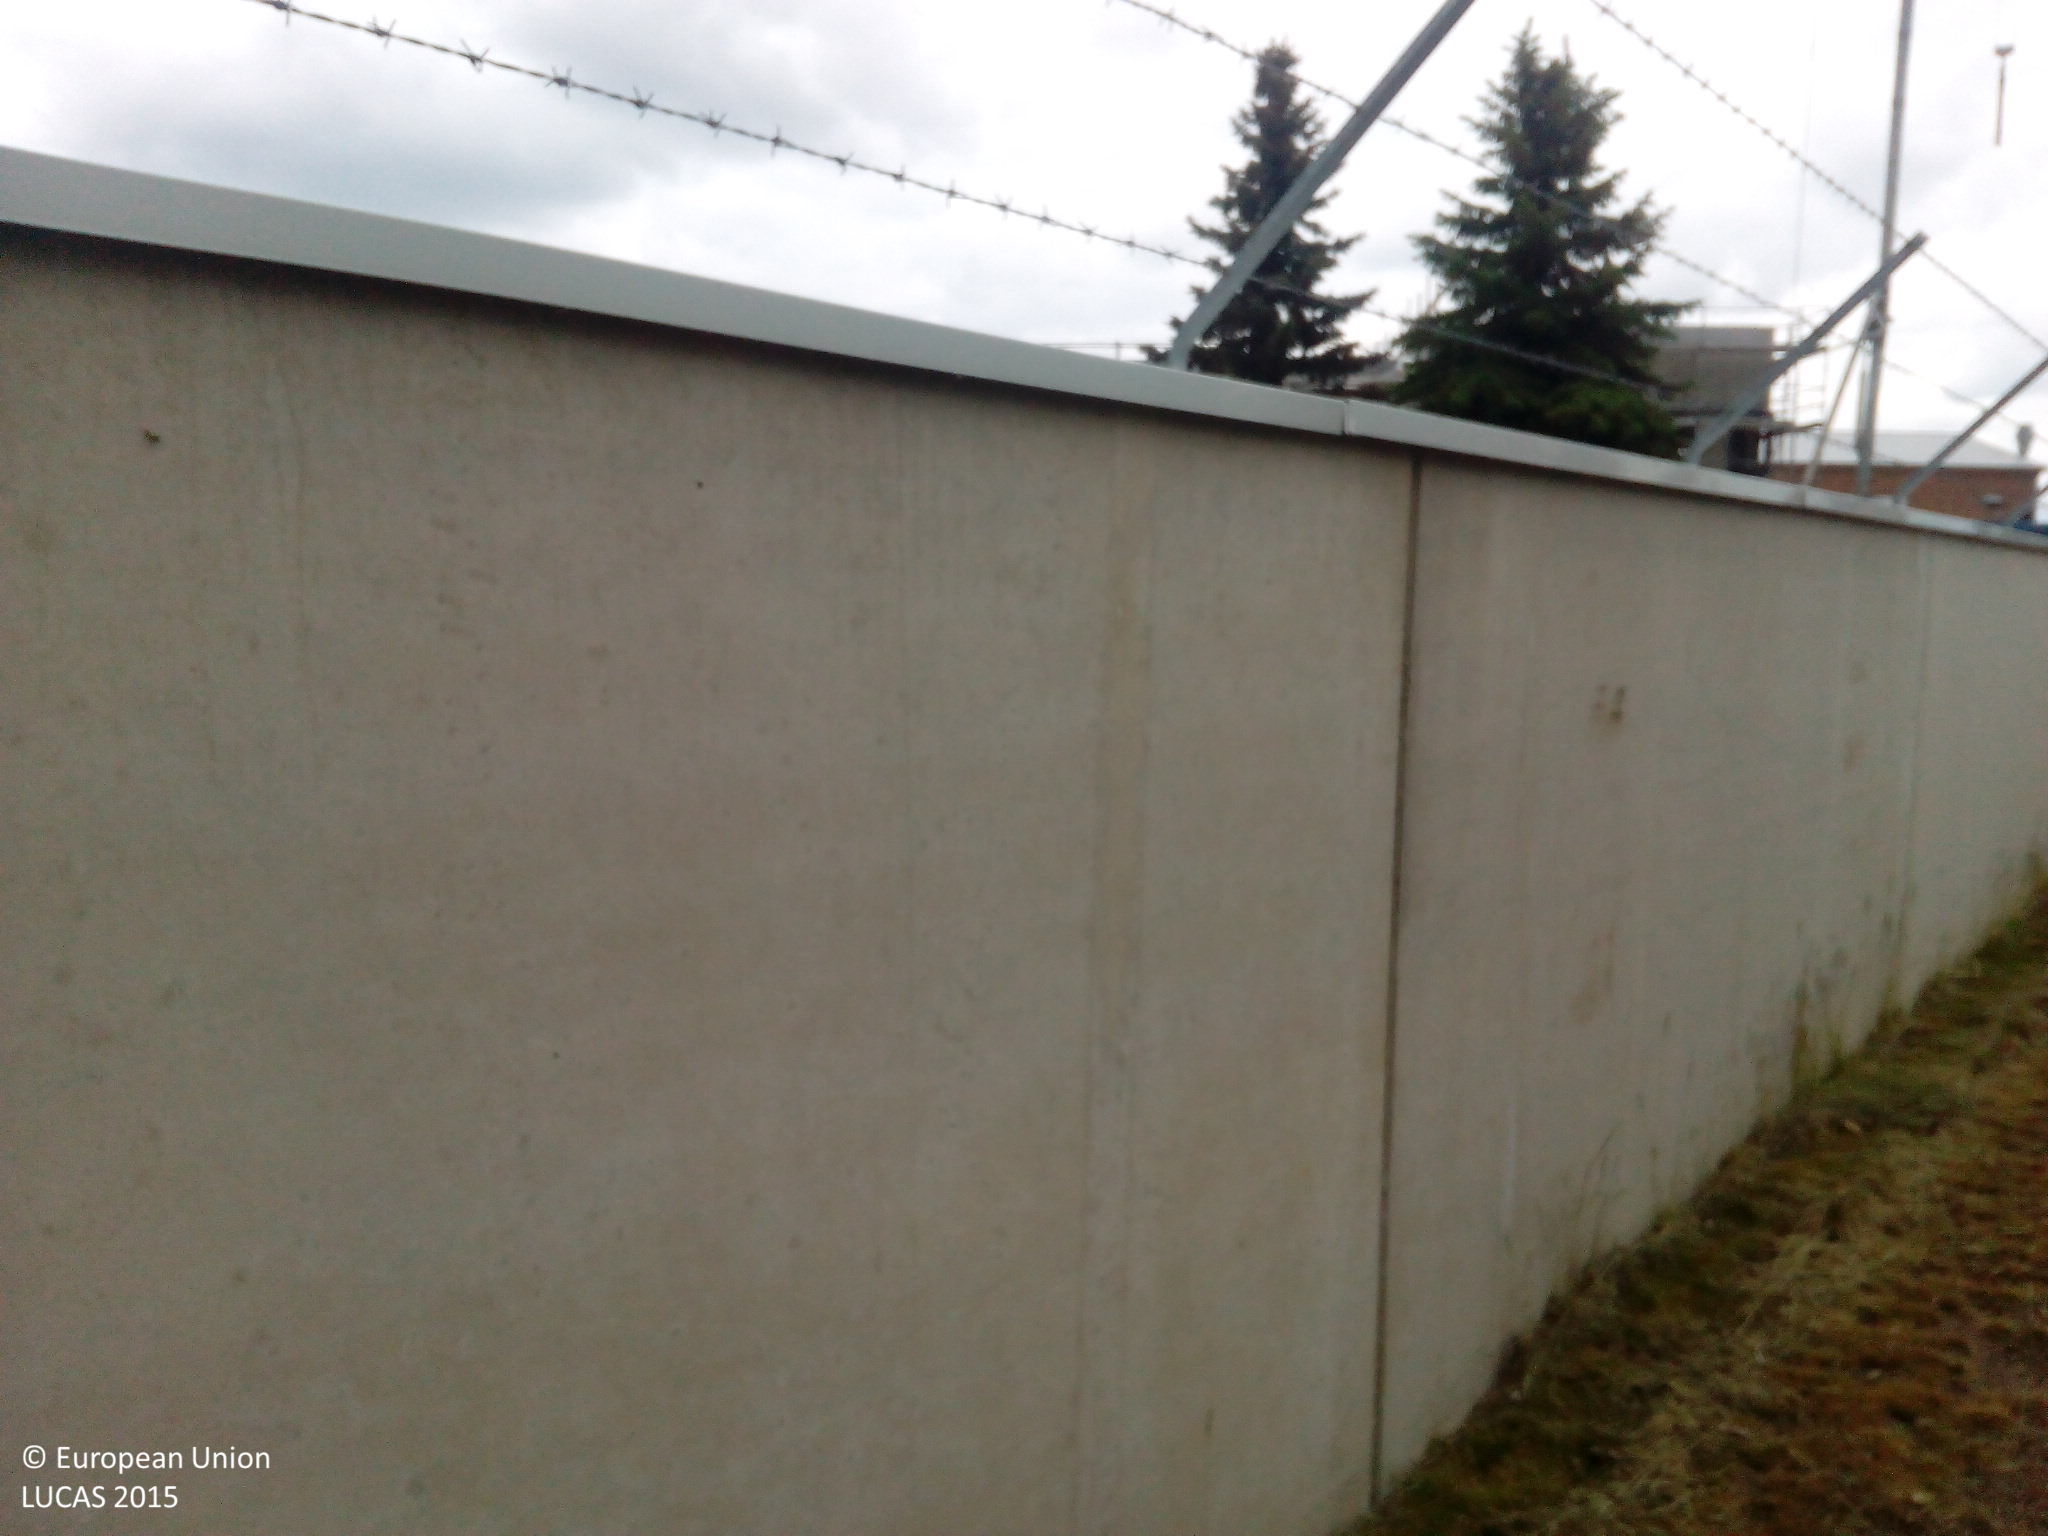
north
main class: Grassland
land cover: Grassland with sparse tree/shrub cover
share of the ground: 50 - 75 %
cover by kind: herbaceous plants 50 %, unconsolidated bare surface 45 %, broadleaved forest trees 5 %
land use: Community services
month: May
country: DE
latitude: 51.6051
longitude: 13.5379
